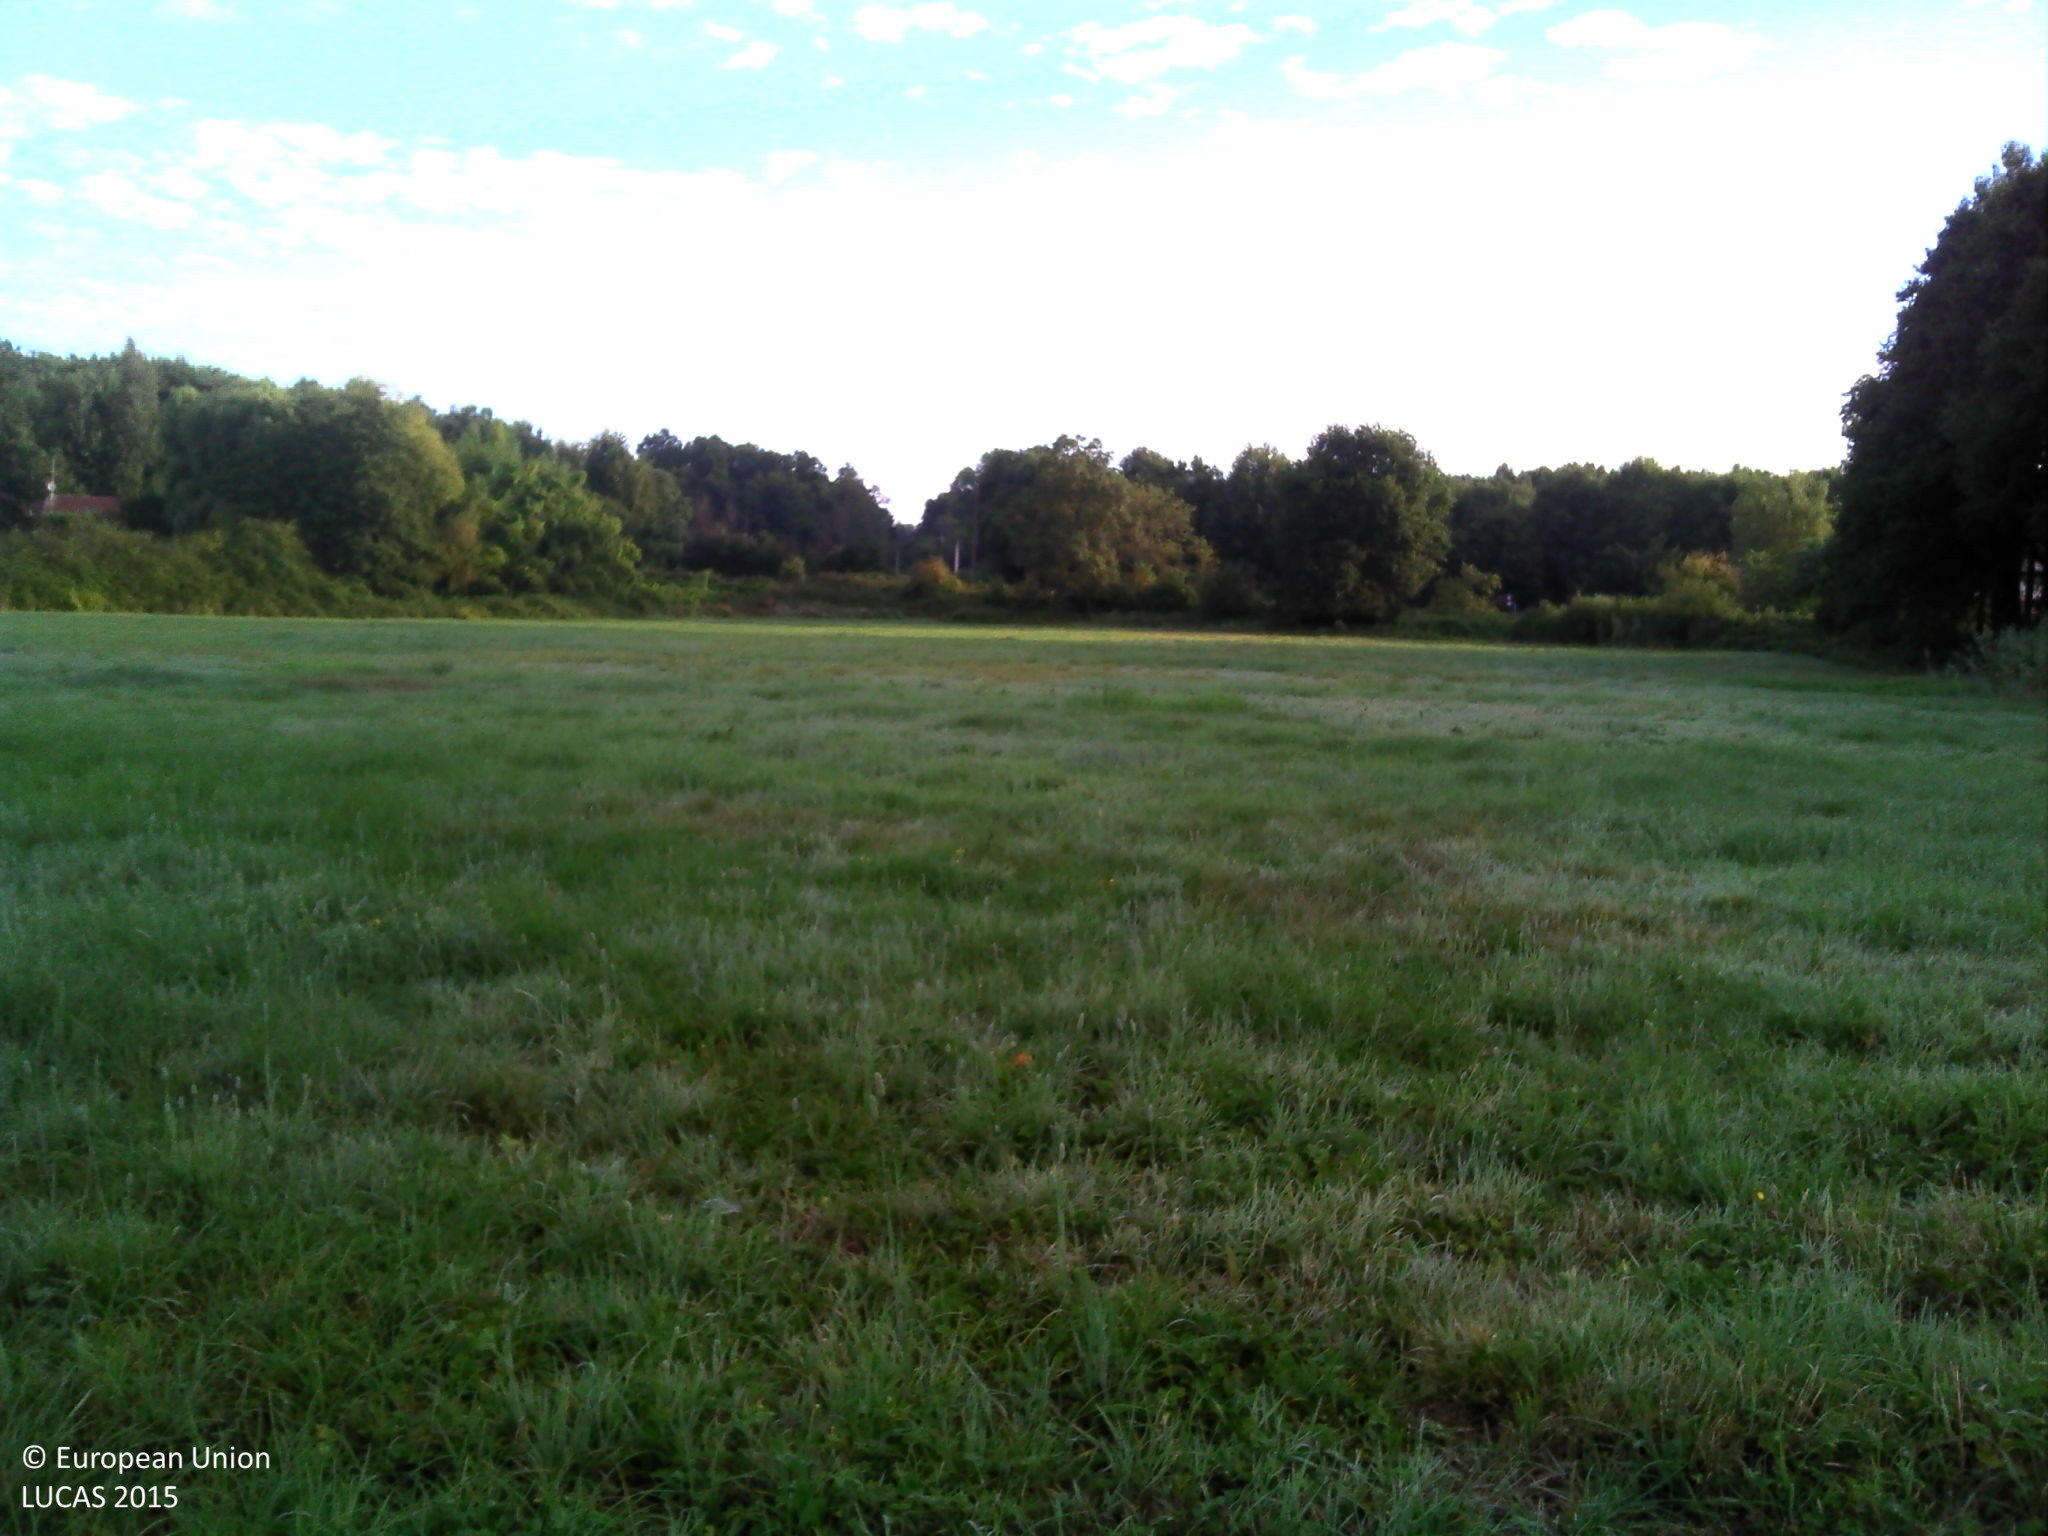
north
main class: Grassland
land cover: Grassland without tree/shrub cover
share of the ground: > 75 %
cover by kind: herbaceous plants 100 %
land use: Agriculture (excluding fallow land and kitchen gardens)
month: August
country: FR
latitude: 47.2030
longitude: 2.1629
